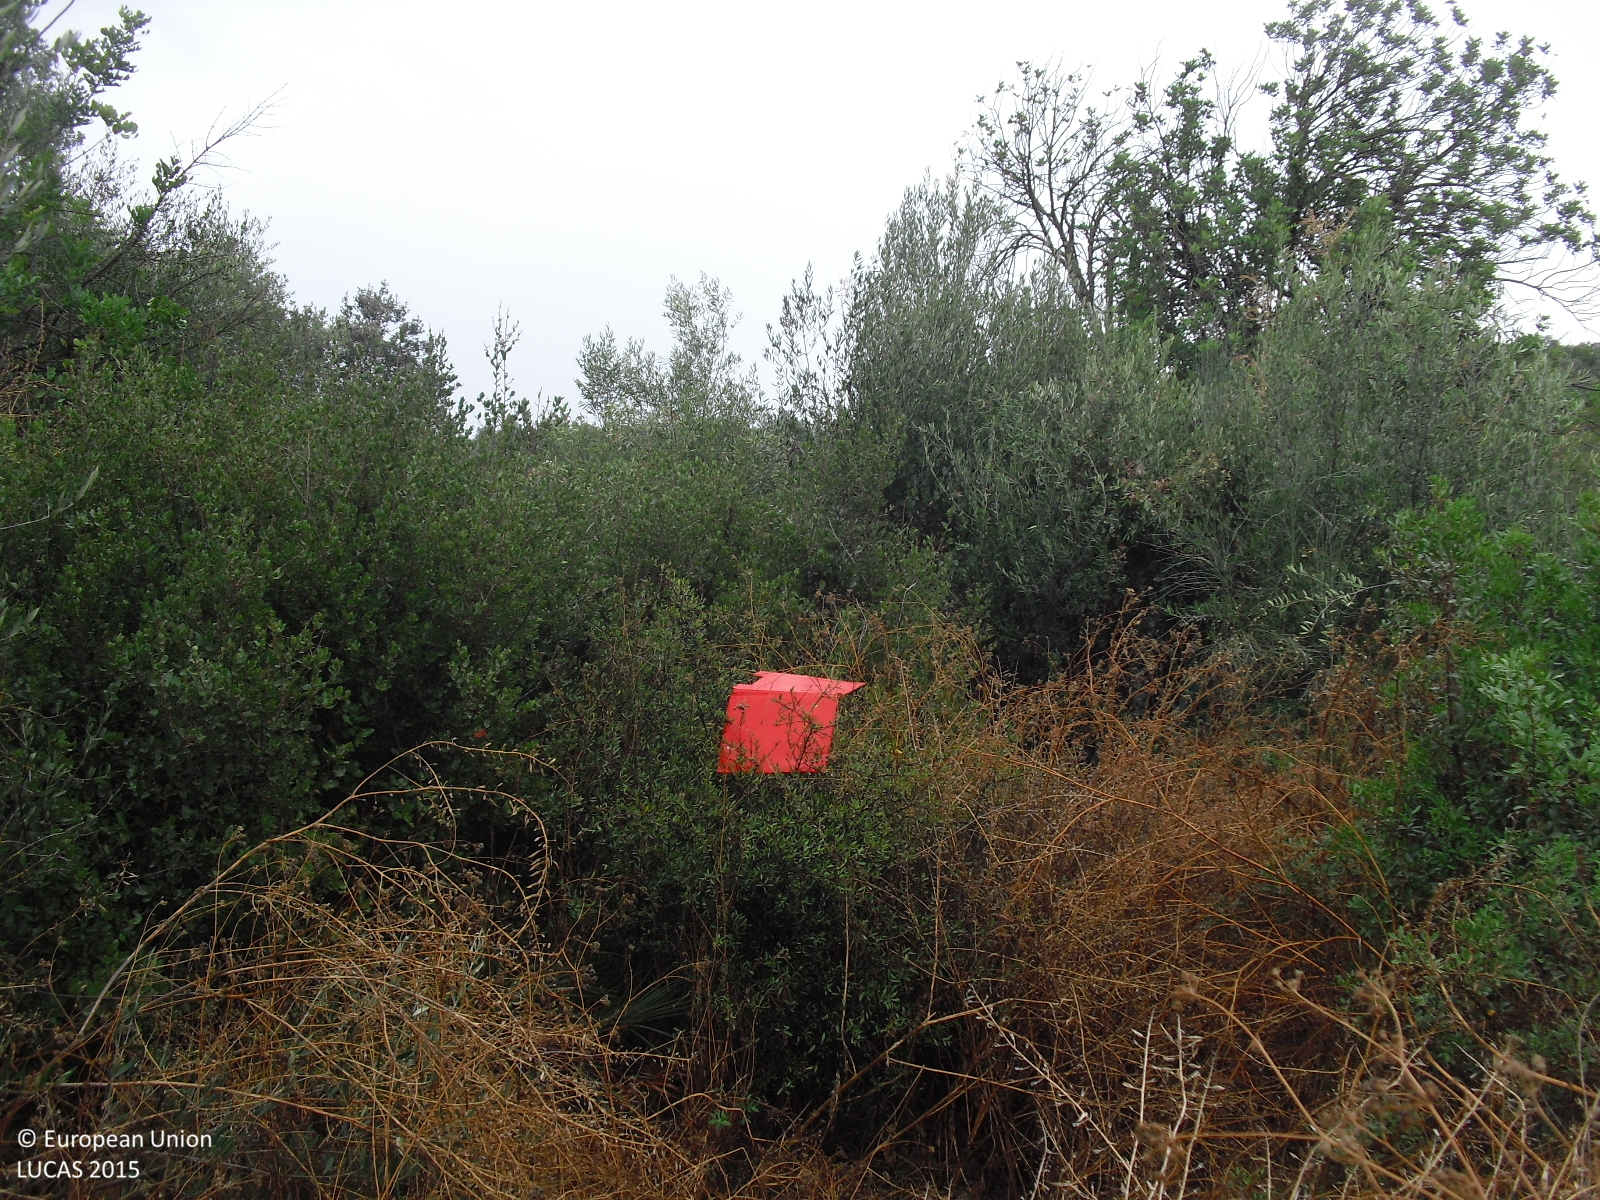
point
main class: Shrubland
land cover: Shrubland with sparse tree cover
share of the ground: > 75 %
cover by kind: shrubs 85 %, herbaceous plants 10 %, broadleaved forest trees 5 %
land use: Semi-natural and natural areas not in use
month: August
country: ES
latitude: 36.9772
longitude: -5.4311
